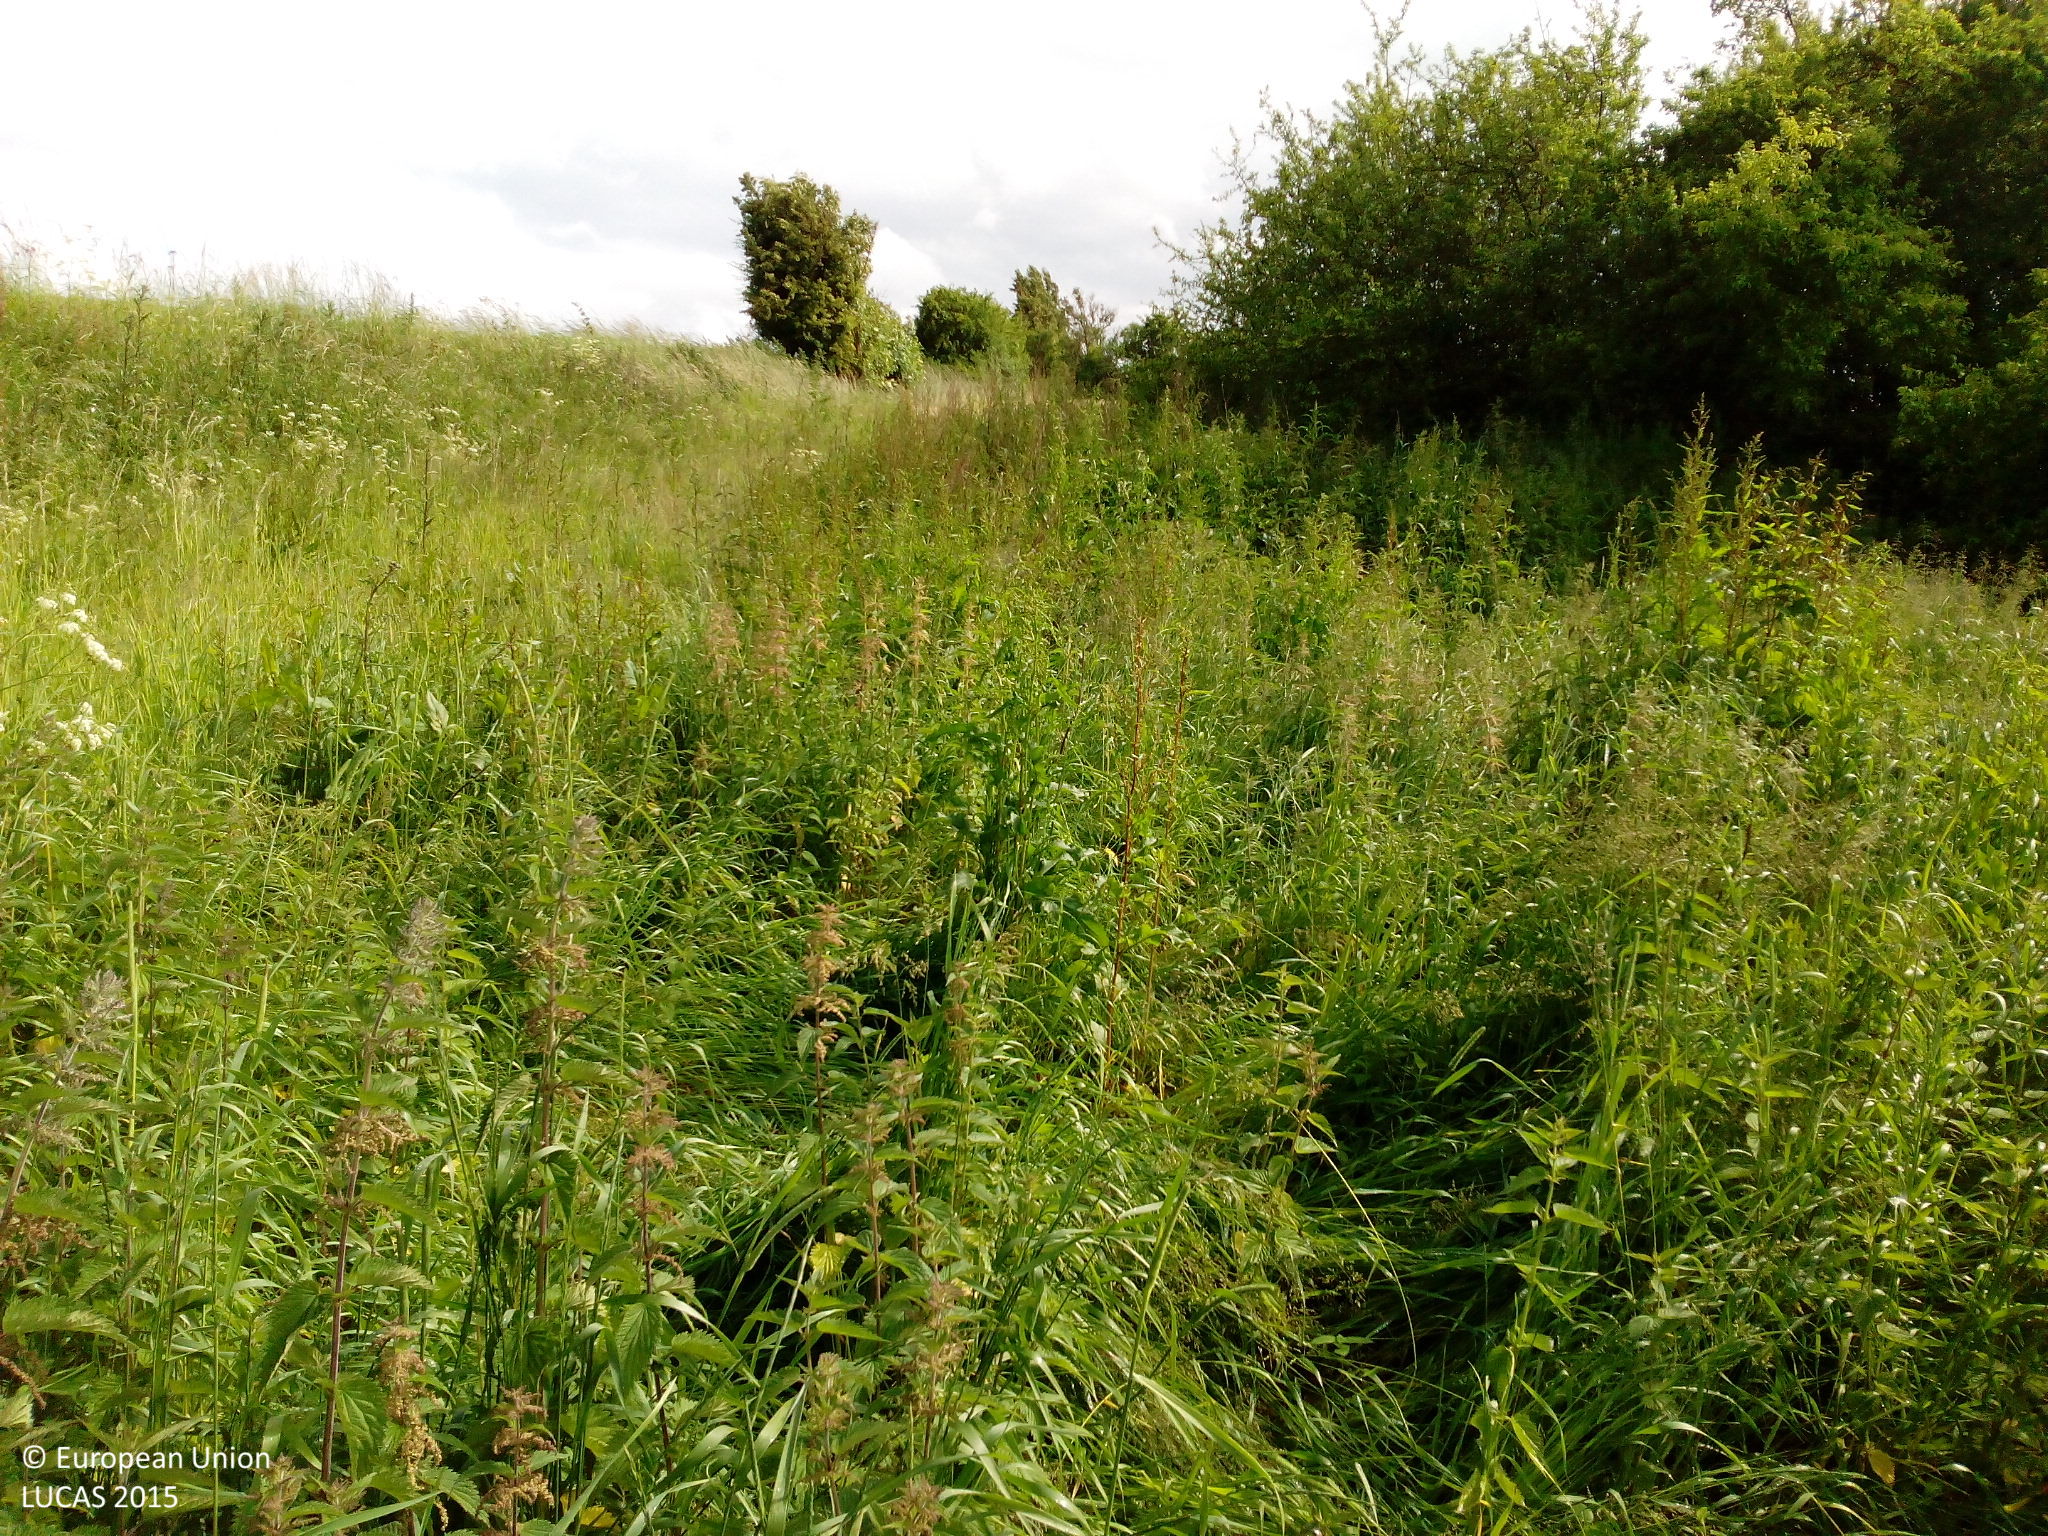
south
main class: Grassland
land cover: Spontaneously vegetated surfaces
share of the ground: > 75 %
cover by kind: herbaceous plants 100 %
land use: Semi-natural and natural areas not in use
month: June
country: DK
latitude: 55.1061
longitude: 10.8927
